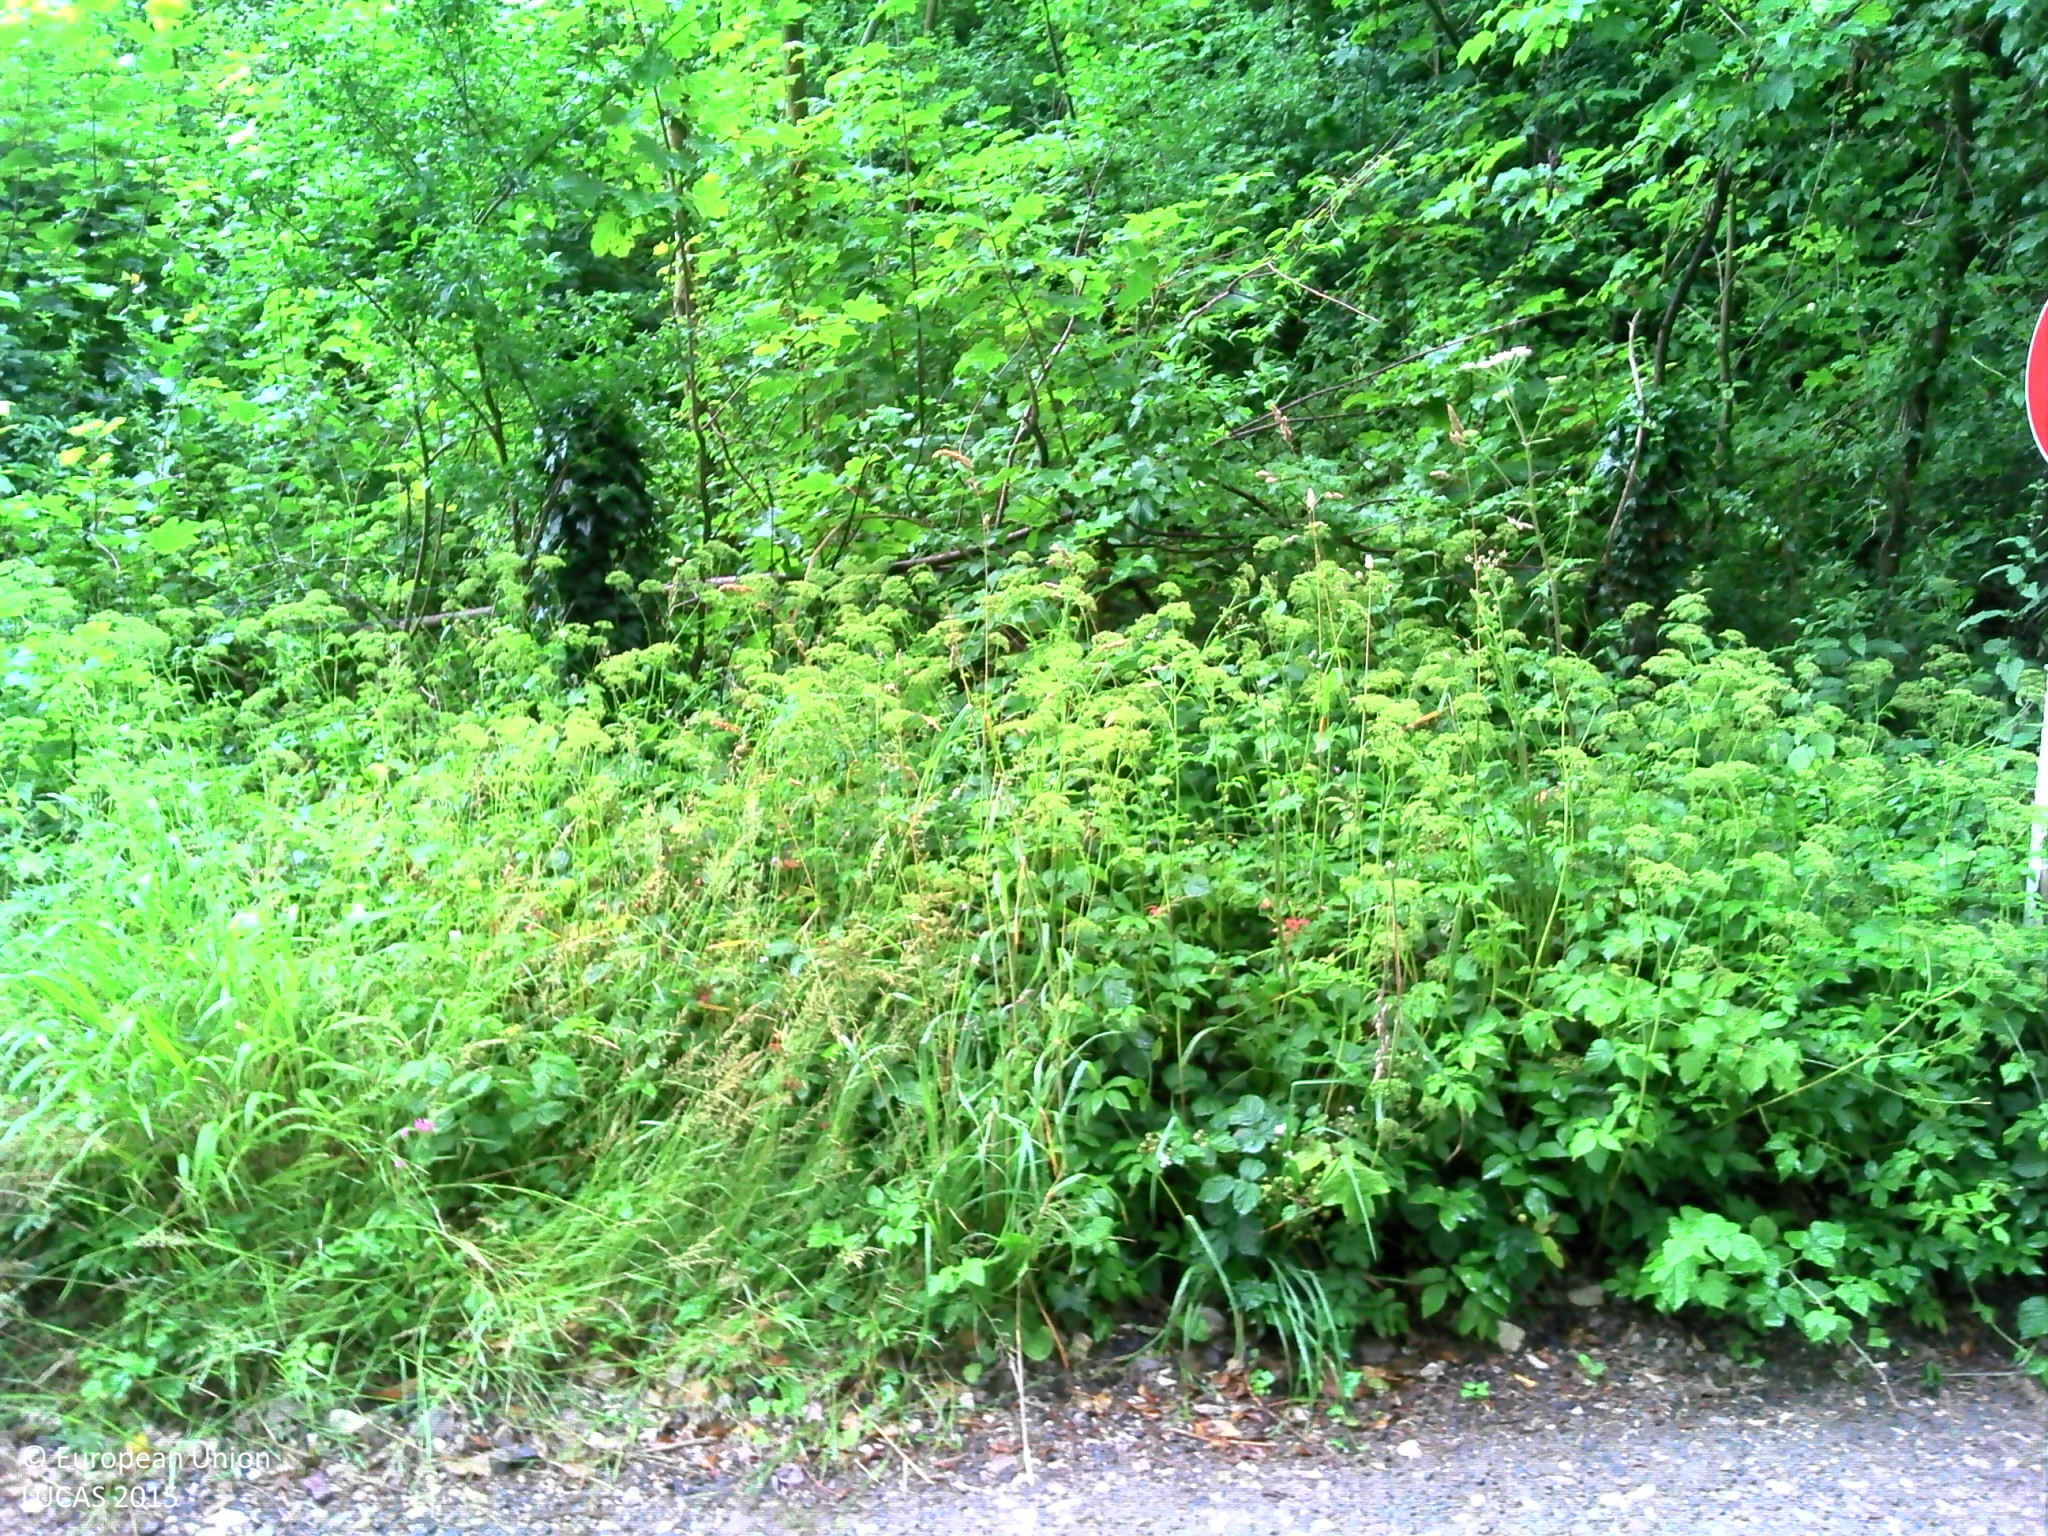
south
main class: Woodland
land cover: Broadleaved woodland
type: mesophytic deciduous forest
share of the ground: > 75 %
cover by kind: broadleaved forest trees 70 %, herbaceous plants 30 %
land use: Residential
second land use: Forestry
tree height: > 5 m
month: July
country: FR
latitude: 50.6152
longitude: 1.6007
